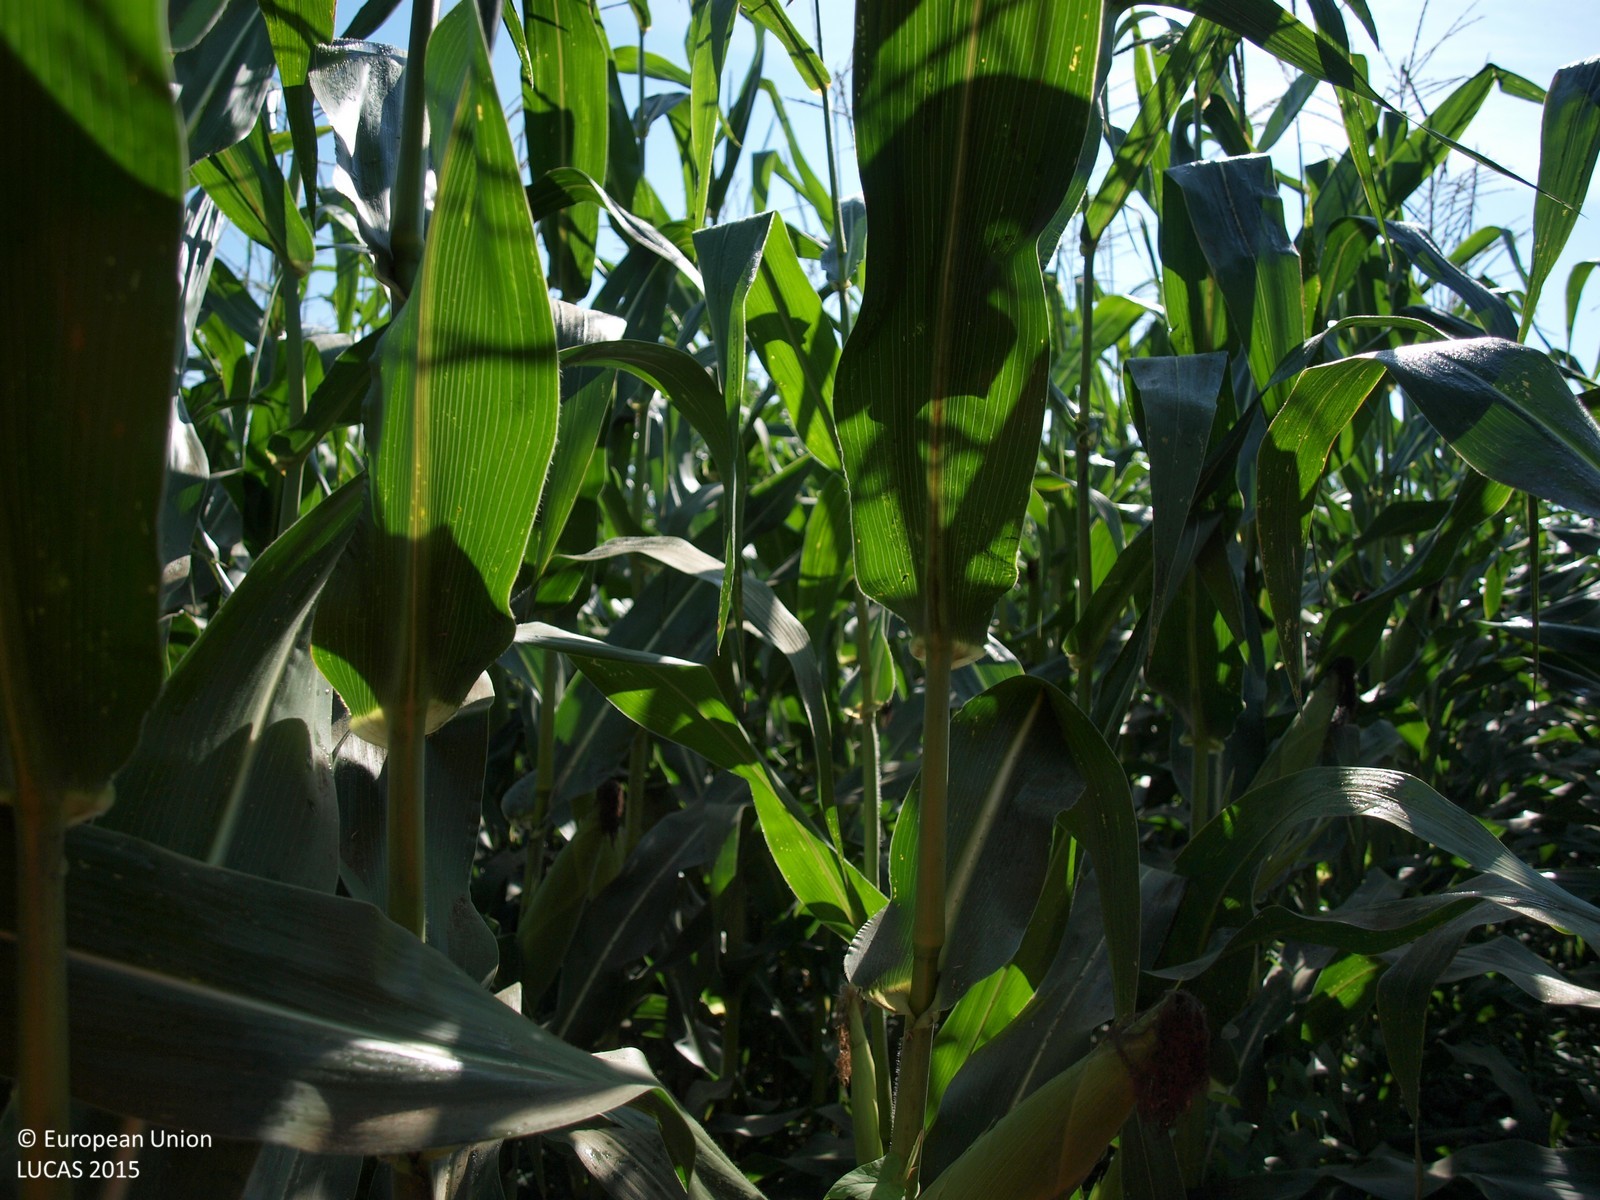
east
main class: Cropland
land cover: Maize
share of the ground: > 75 %
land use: Agriculture (excluding fallow land and kitchen gardens)
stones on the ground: < 10 %
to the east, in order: Maize; Grassland without tree/shrub cover; Rivers and streams; Grassland without tree/shrub cover; Maize
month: August
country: HR
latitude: 46.0036
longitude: 16.2879
